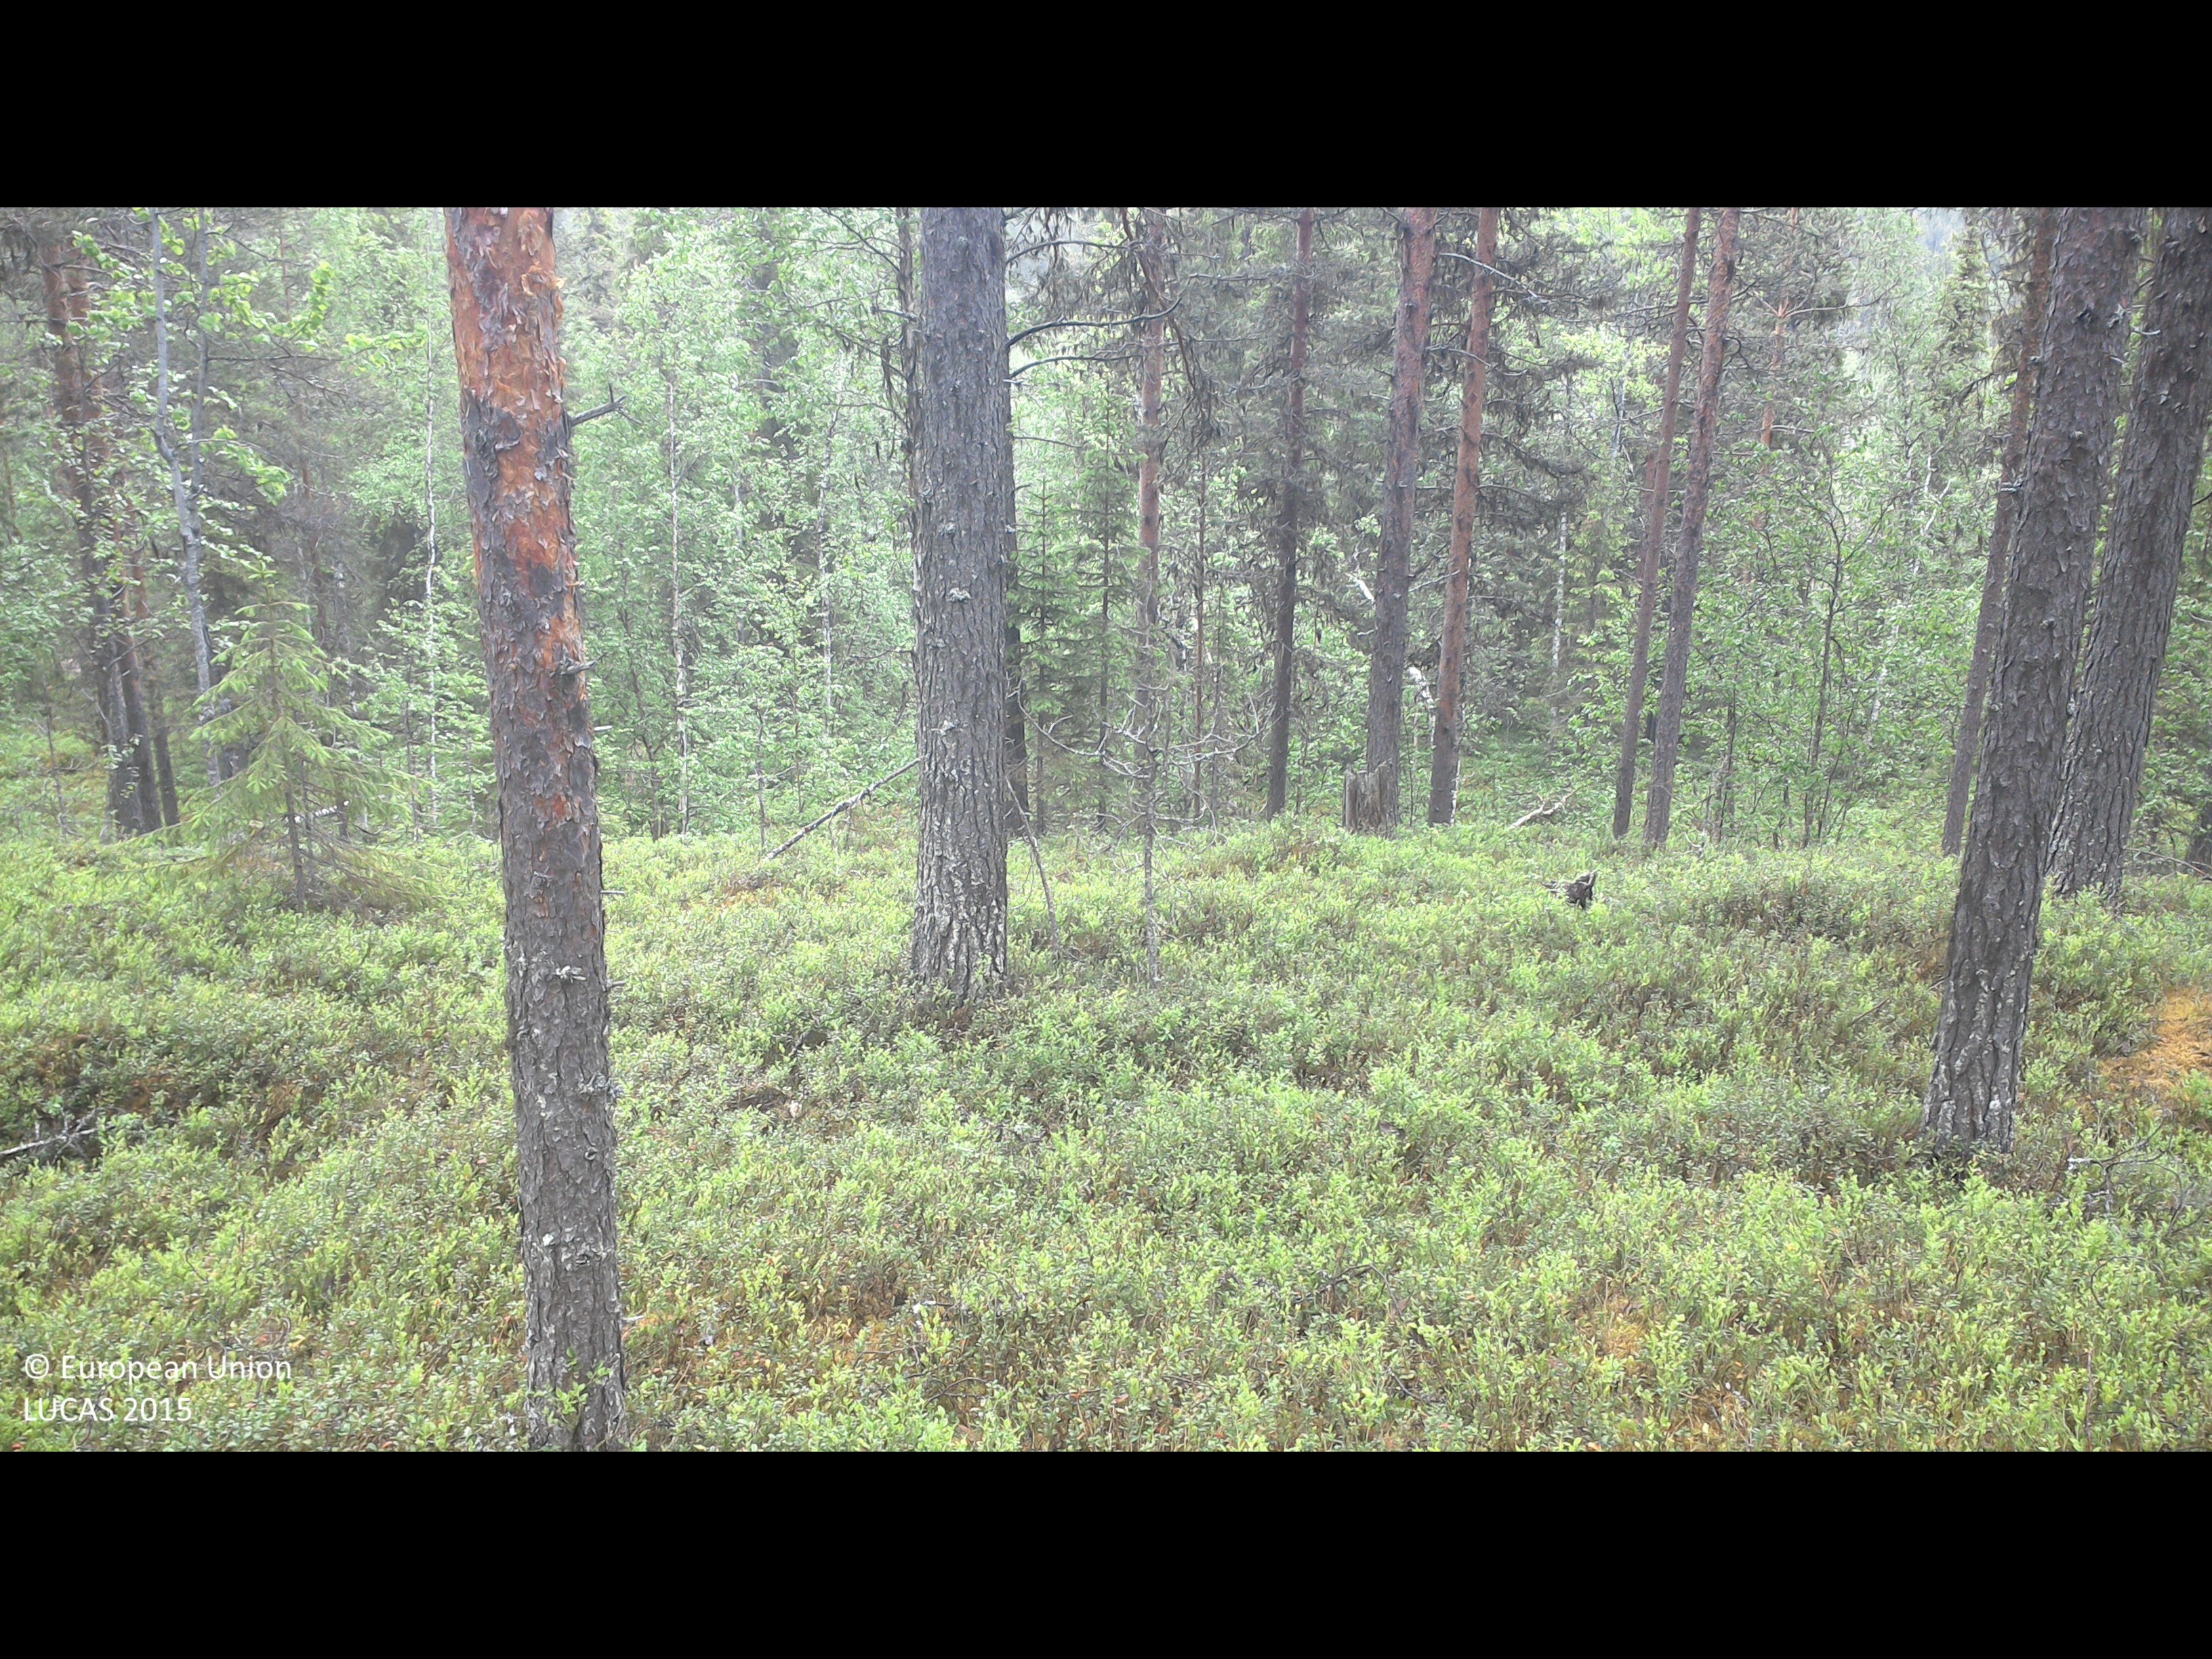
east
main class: Woodland
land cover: Pine dominated coniferous woodland
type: boreal forest
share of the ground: 25 - 50 %
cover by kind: shrubs 70 %, coniferous forest trees 30 %
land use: Forestry
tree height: > 5 m
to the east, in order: Pine dominated coniferous woodland; Ditches and canals; Paved roads, cycling and walking lanes; Spruce dominated mixed woodland; Rivers and streams; Spruce dominated mixed woodland
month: June
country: SE
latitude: 66.8101
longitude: 22.6449
